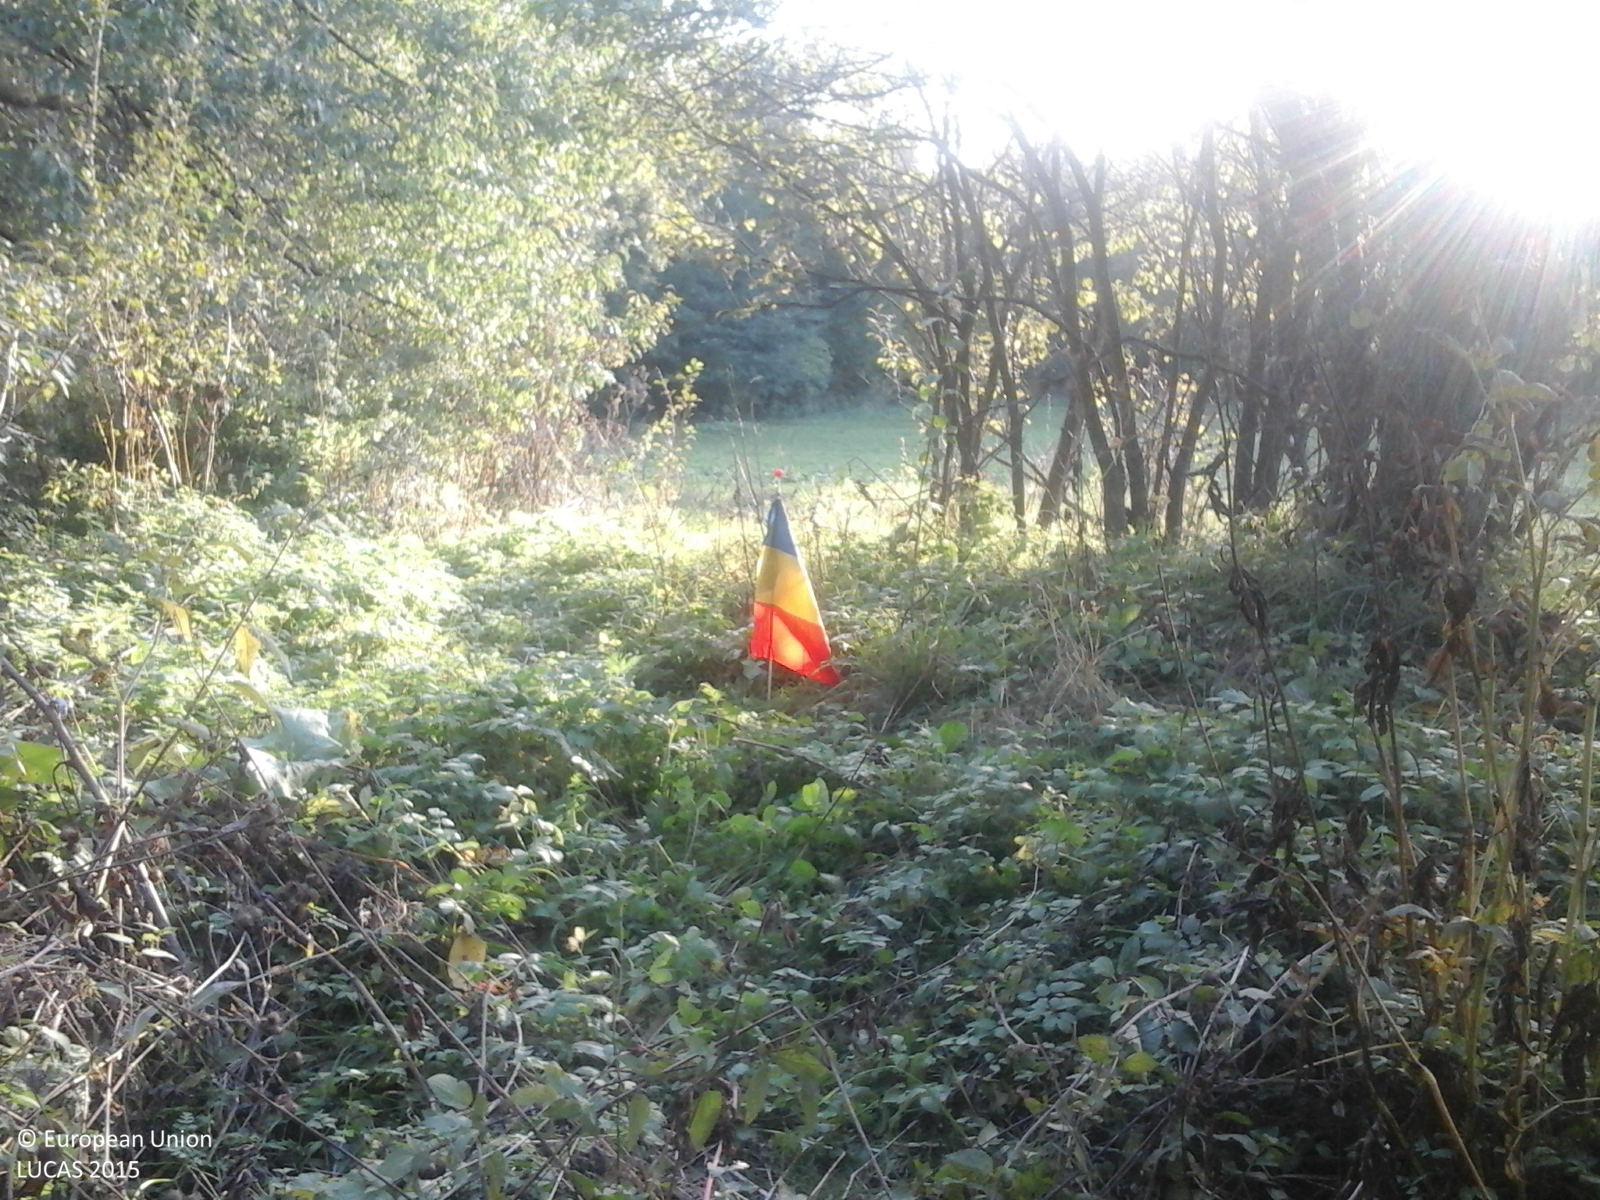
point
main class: Woodland
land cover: Broadleaved woodland
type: acidophilous oak and oak-birch forest
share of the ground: > 75 %
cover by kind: broadleaved forest trees 100 %
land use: Forestry
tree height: > 5 m
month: October
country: RO
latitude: 46.2714
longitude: 25.4036
